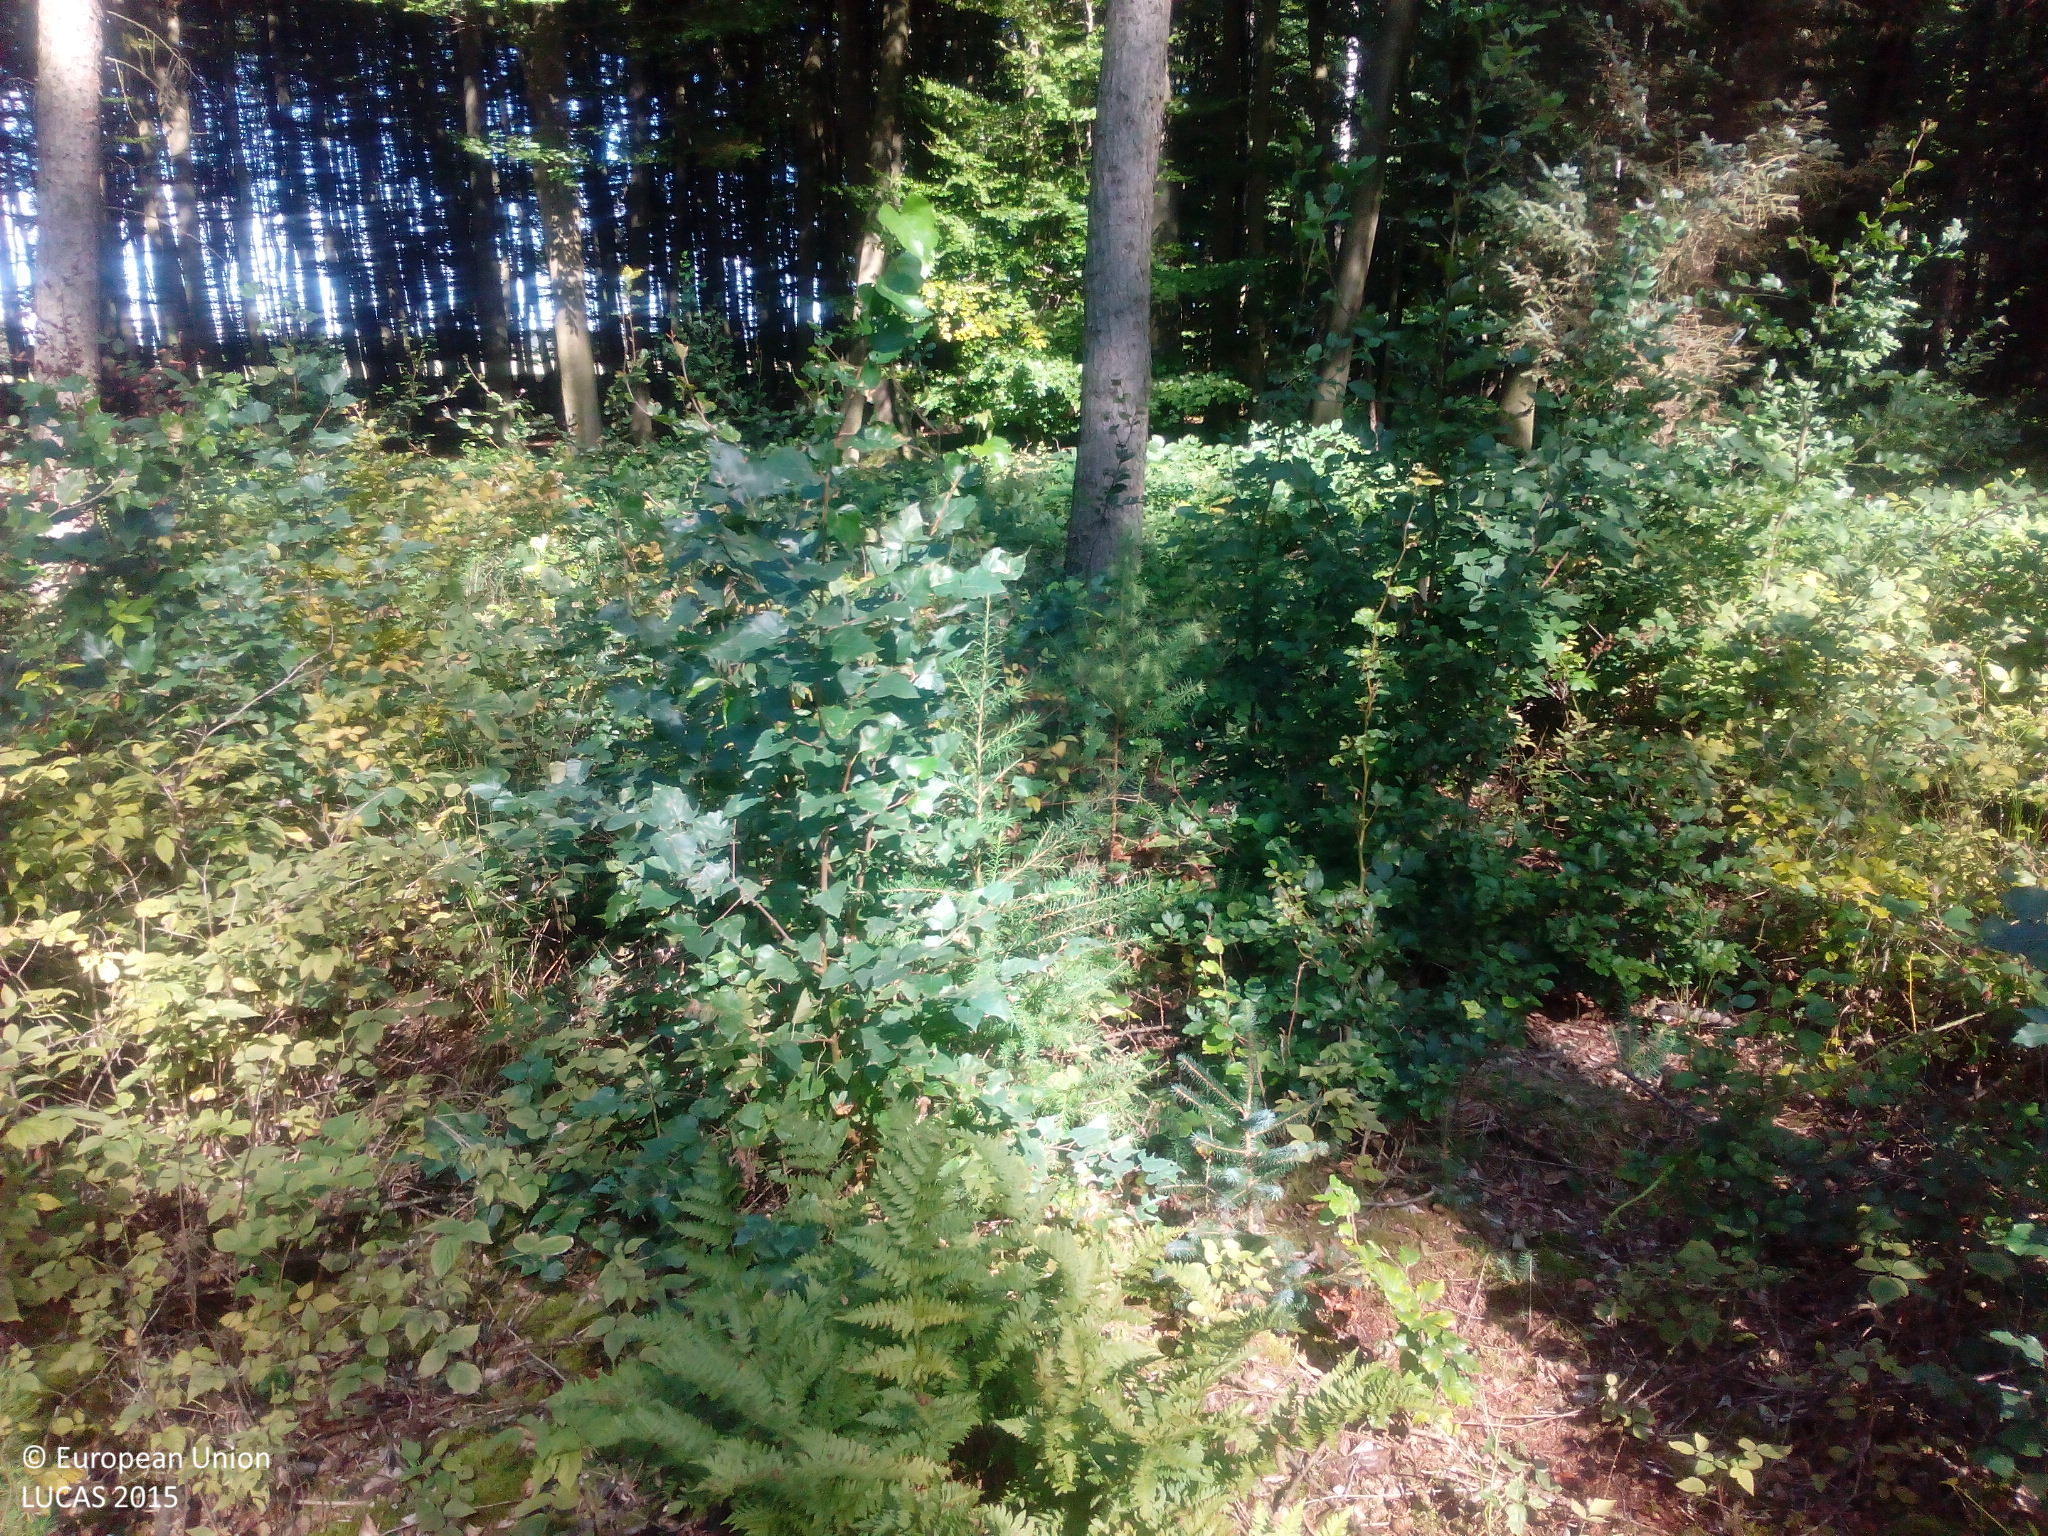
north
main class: Woodland
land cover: Other mixed woodland
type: hemiboreal forest and nemoral coniferous forest and mixed broadleaved-coniferous forest
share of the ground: > 75 %
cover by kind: coniferous forest trees 70 %, broadleaved forest trees 25 %, shrubs 5 %
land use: Forestry
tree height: > 5 m
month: September
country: DE
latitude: 54.1171
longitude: 12.3091
